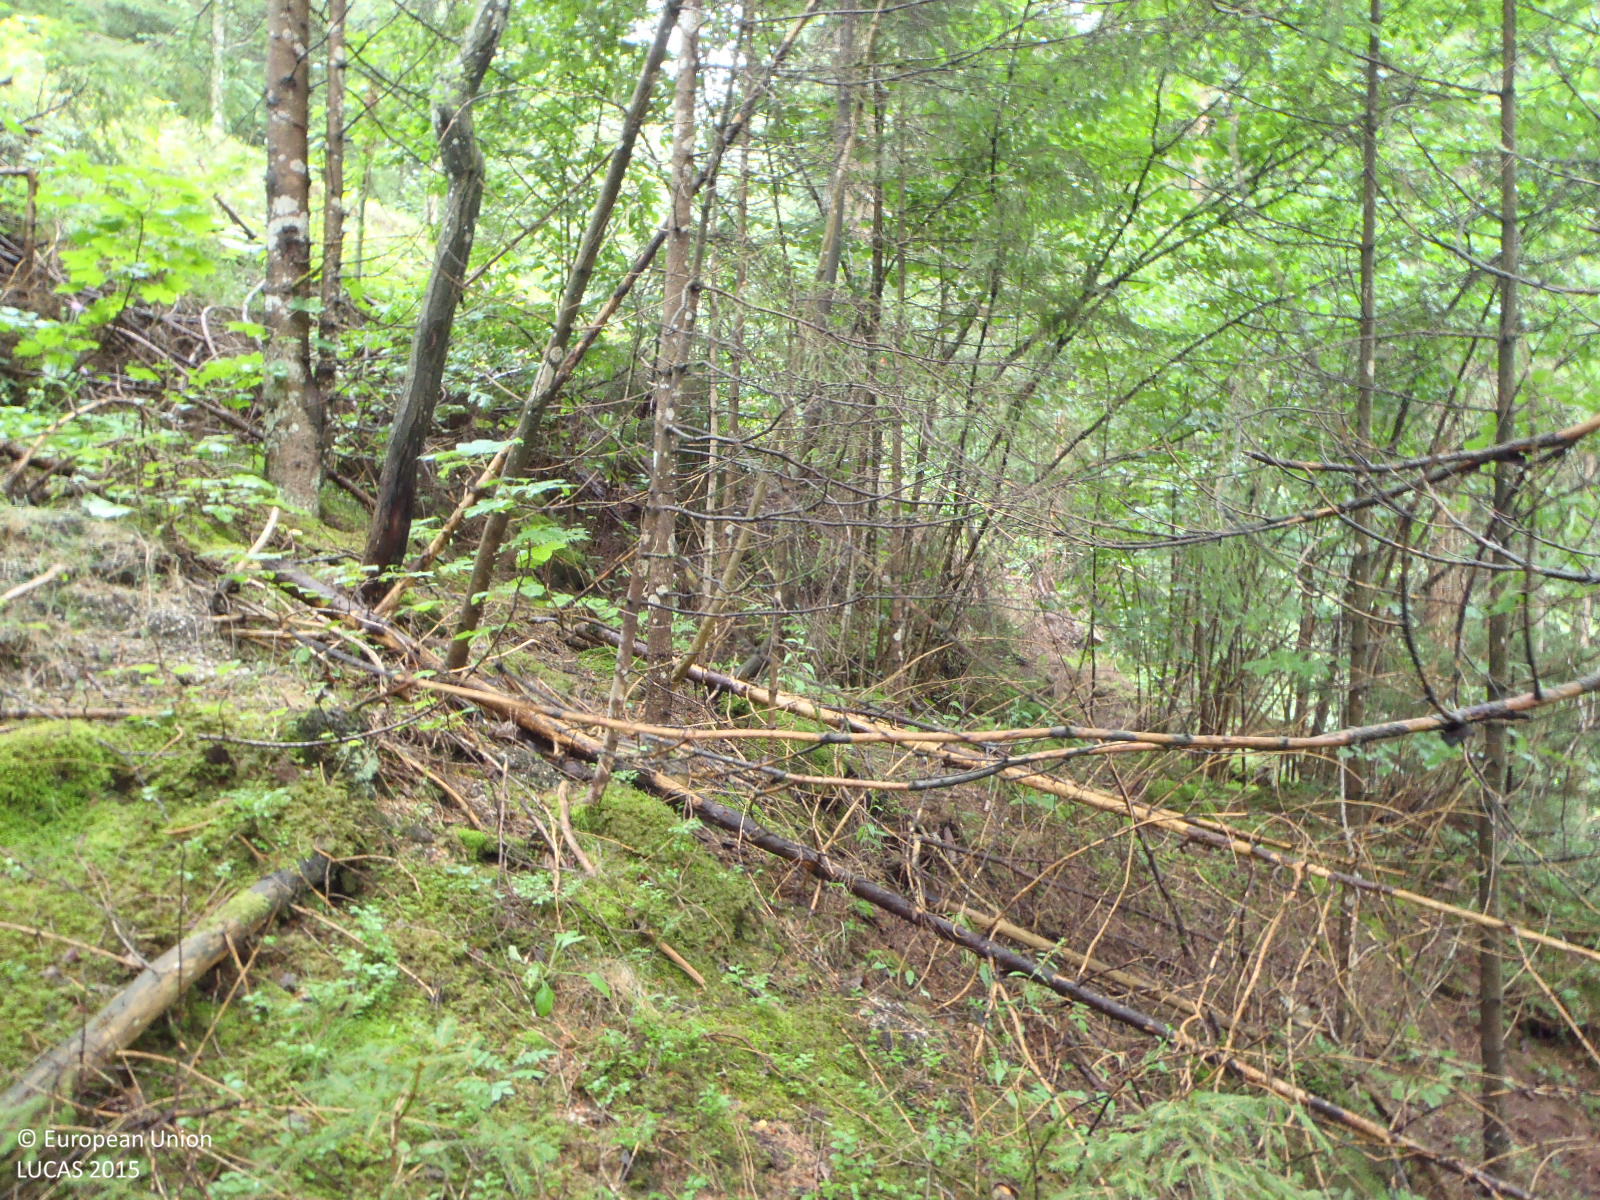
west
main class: Woodland
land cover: Spruce dominated coniferous woodland
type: alpine coniferous forest
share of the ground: > 75 %
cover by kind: coniferous forest trees 85 %, broadleaved forest trees 15 %
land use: Forestry
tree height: > 5 m
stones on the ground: < 10 %
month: July
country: AT
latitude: 47.2896
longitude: 11.8628
